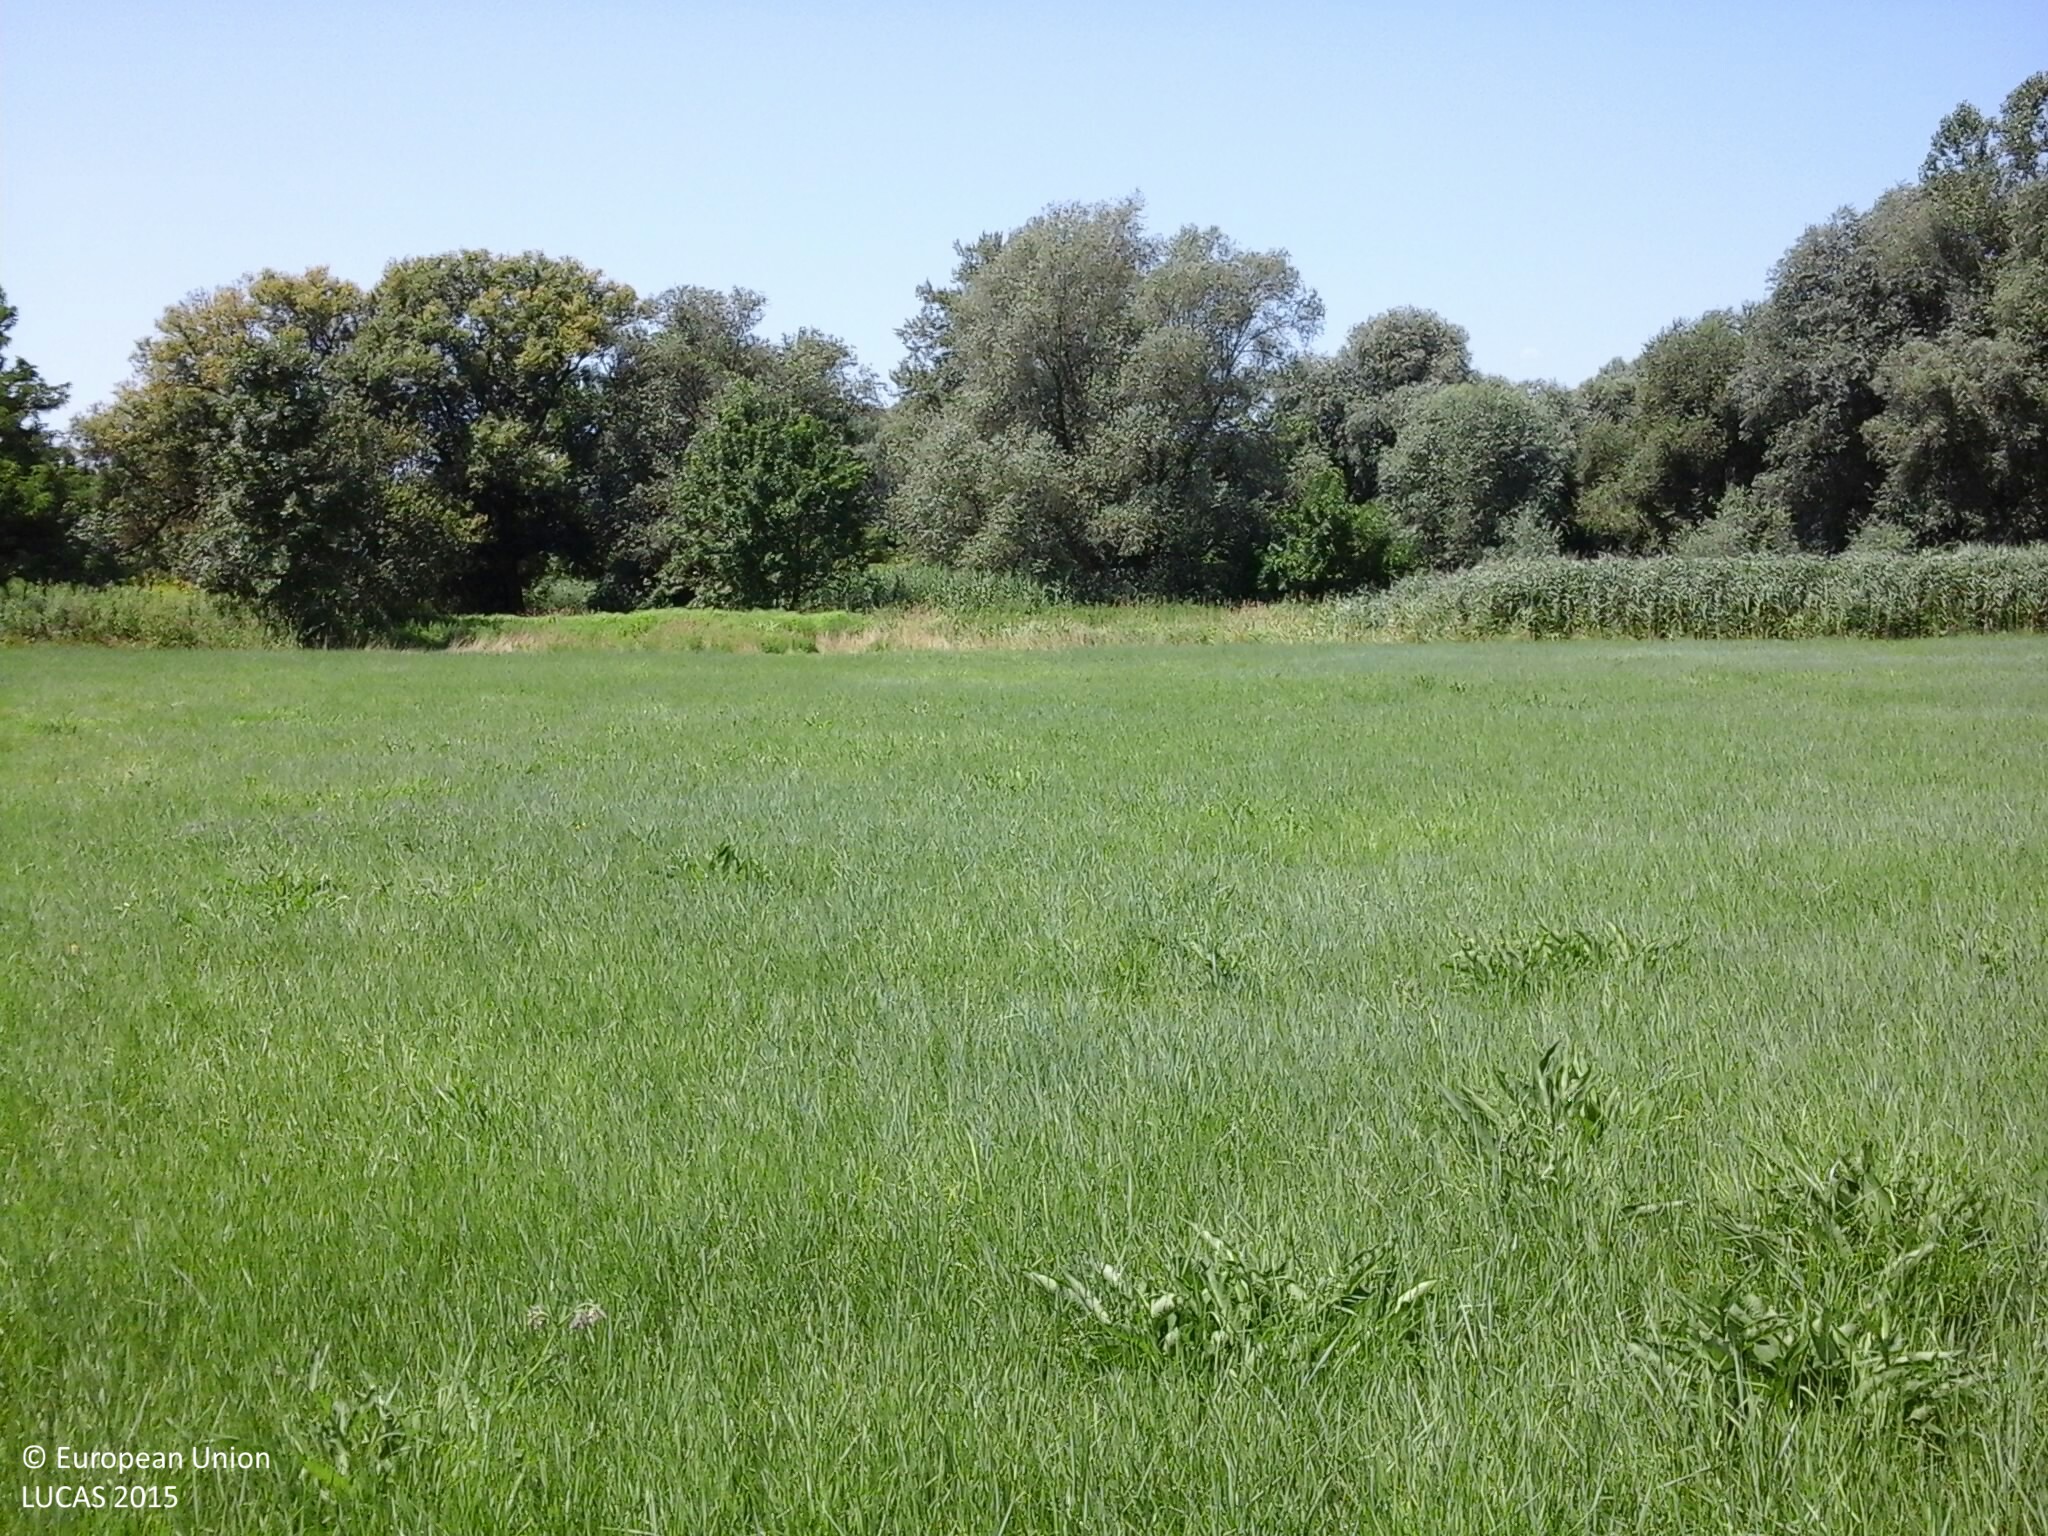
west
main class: Grassland
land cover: Grassland without tree/shrub cover
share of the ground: > 75 %
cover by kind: herbaceous plants 100 %
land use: Agriculture (excluding fallow land and kitchen gardens)
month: July
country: HU
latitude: 46.9969
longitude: 16.5911
